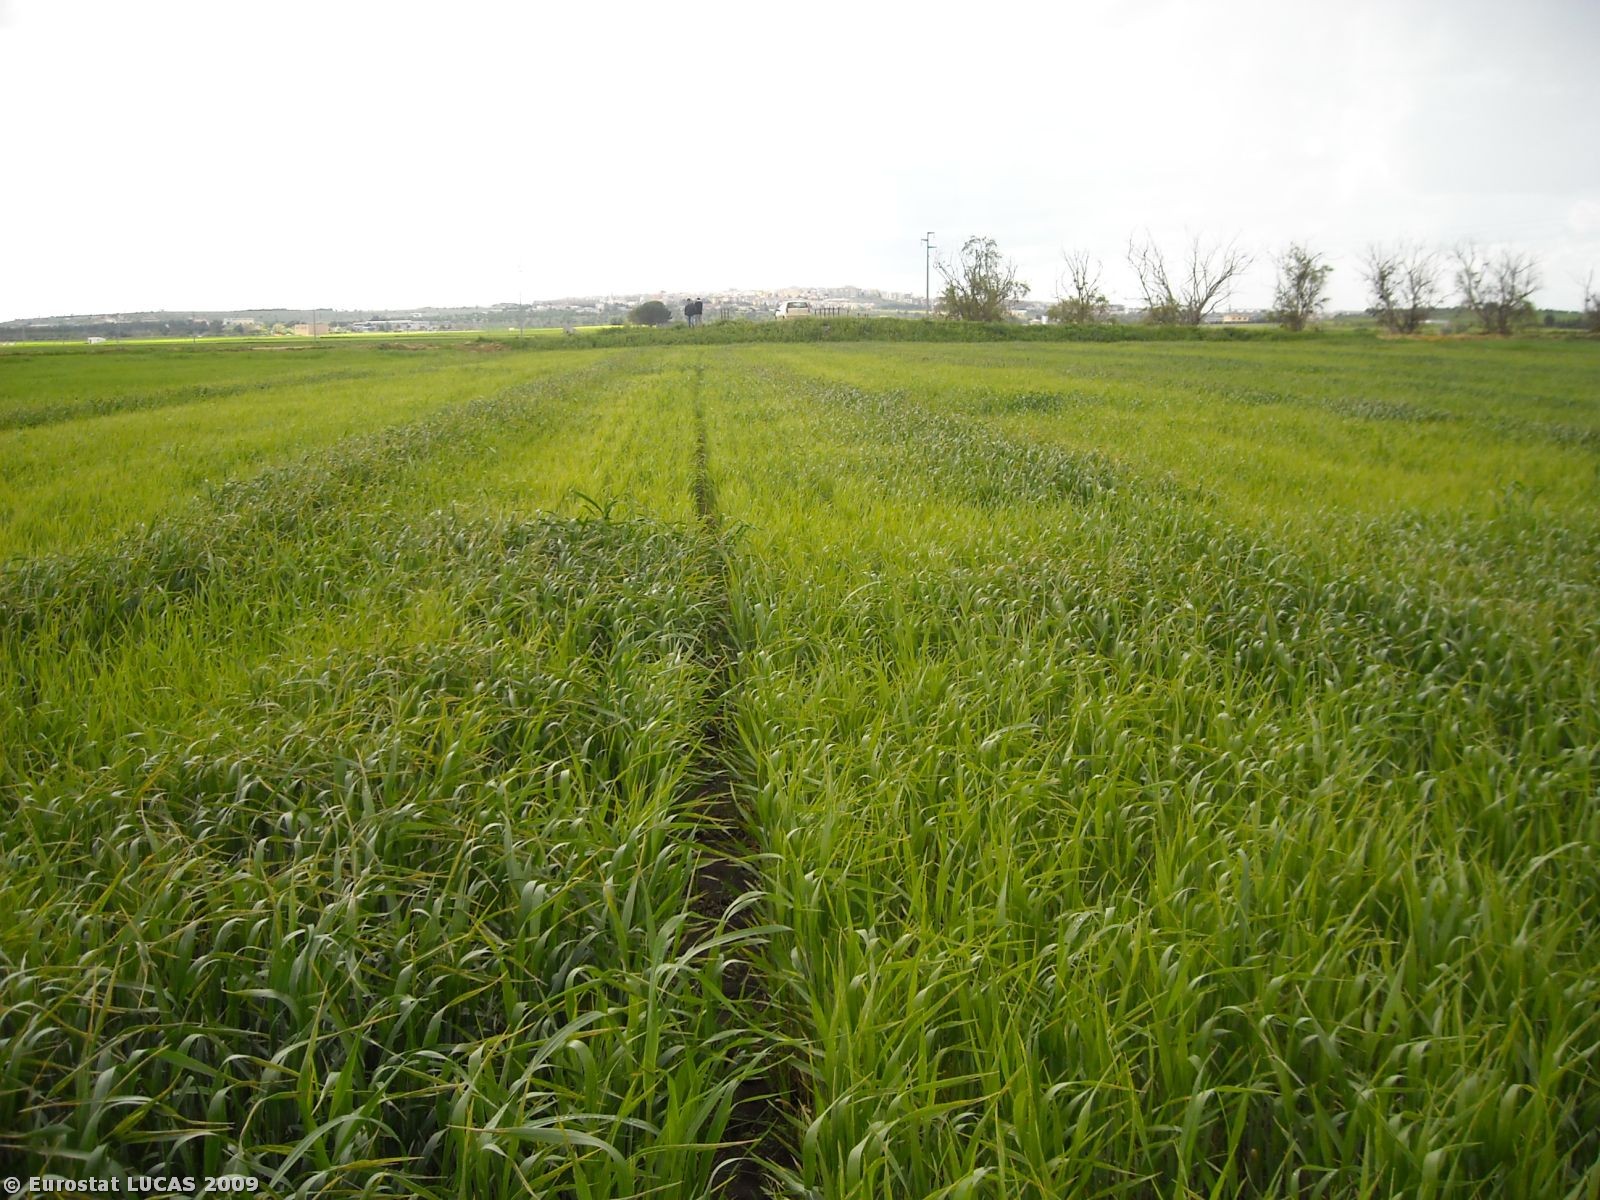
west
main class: Cropland
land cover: Durum wheat
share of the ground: > 75 %
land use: Agriculture (excluding fallow land and kitchen gardens)
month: April
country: IT
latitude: 40.8069
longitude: 16.6041
